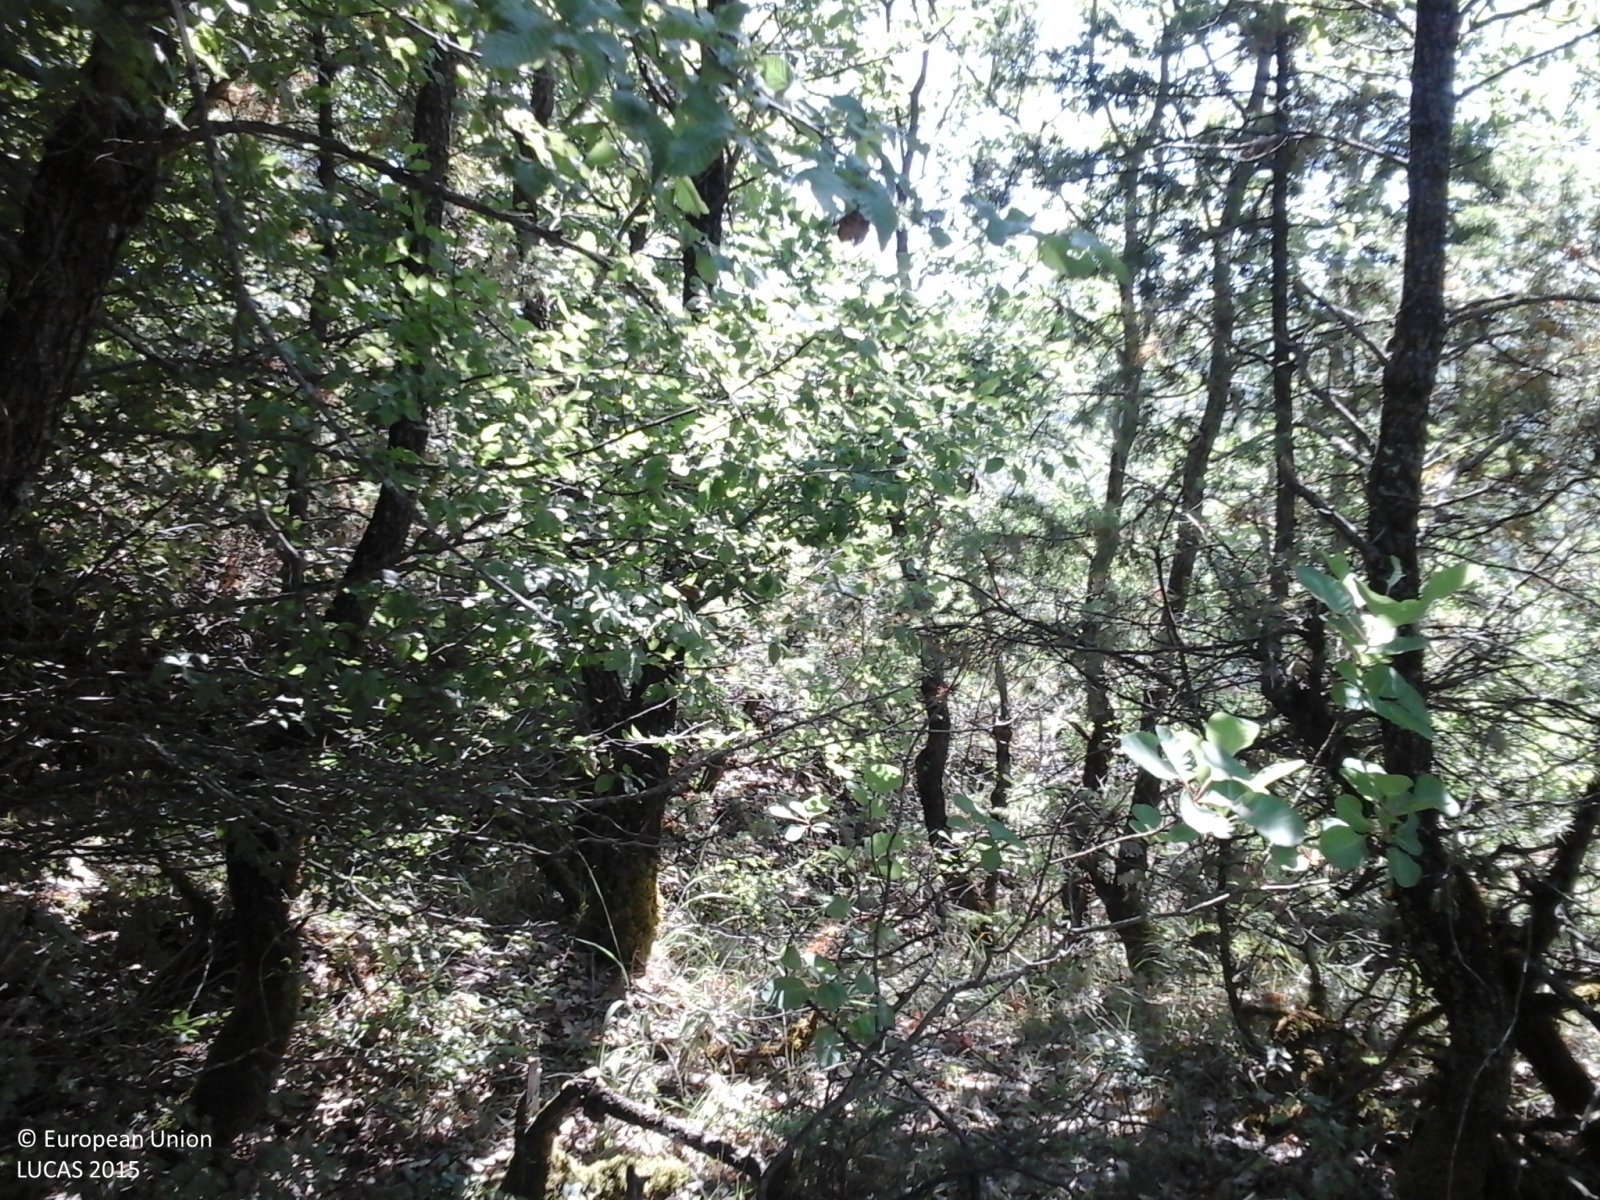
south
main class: Woodland
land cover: Broadleaved woodland
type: thermophilous deciduous forest
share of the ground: > 75 %
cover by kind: broadleaved forest trees 85 %, herbaceous plants 10 %, shrubs 5 %
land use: Forestry
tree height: > 5 m
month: July
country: GR
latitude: 40.0956
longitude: 20.7383
